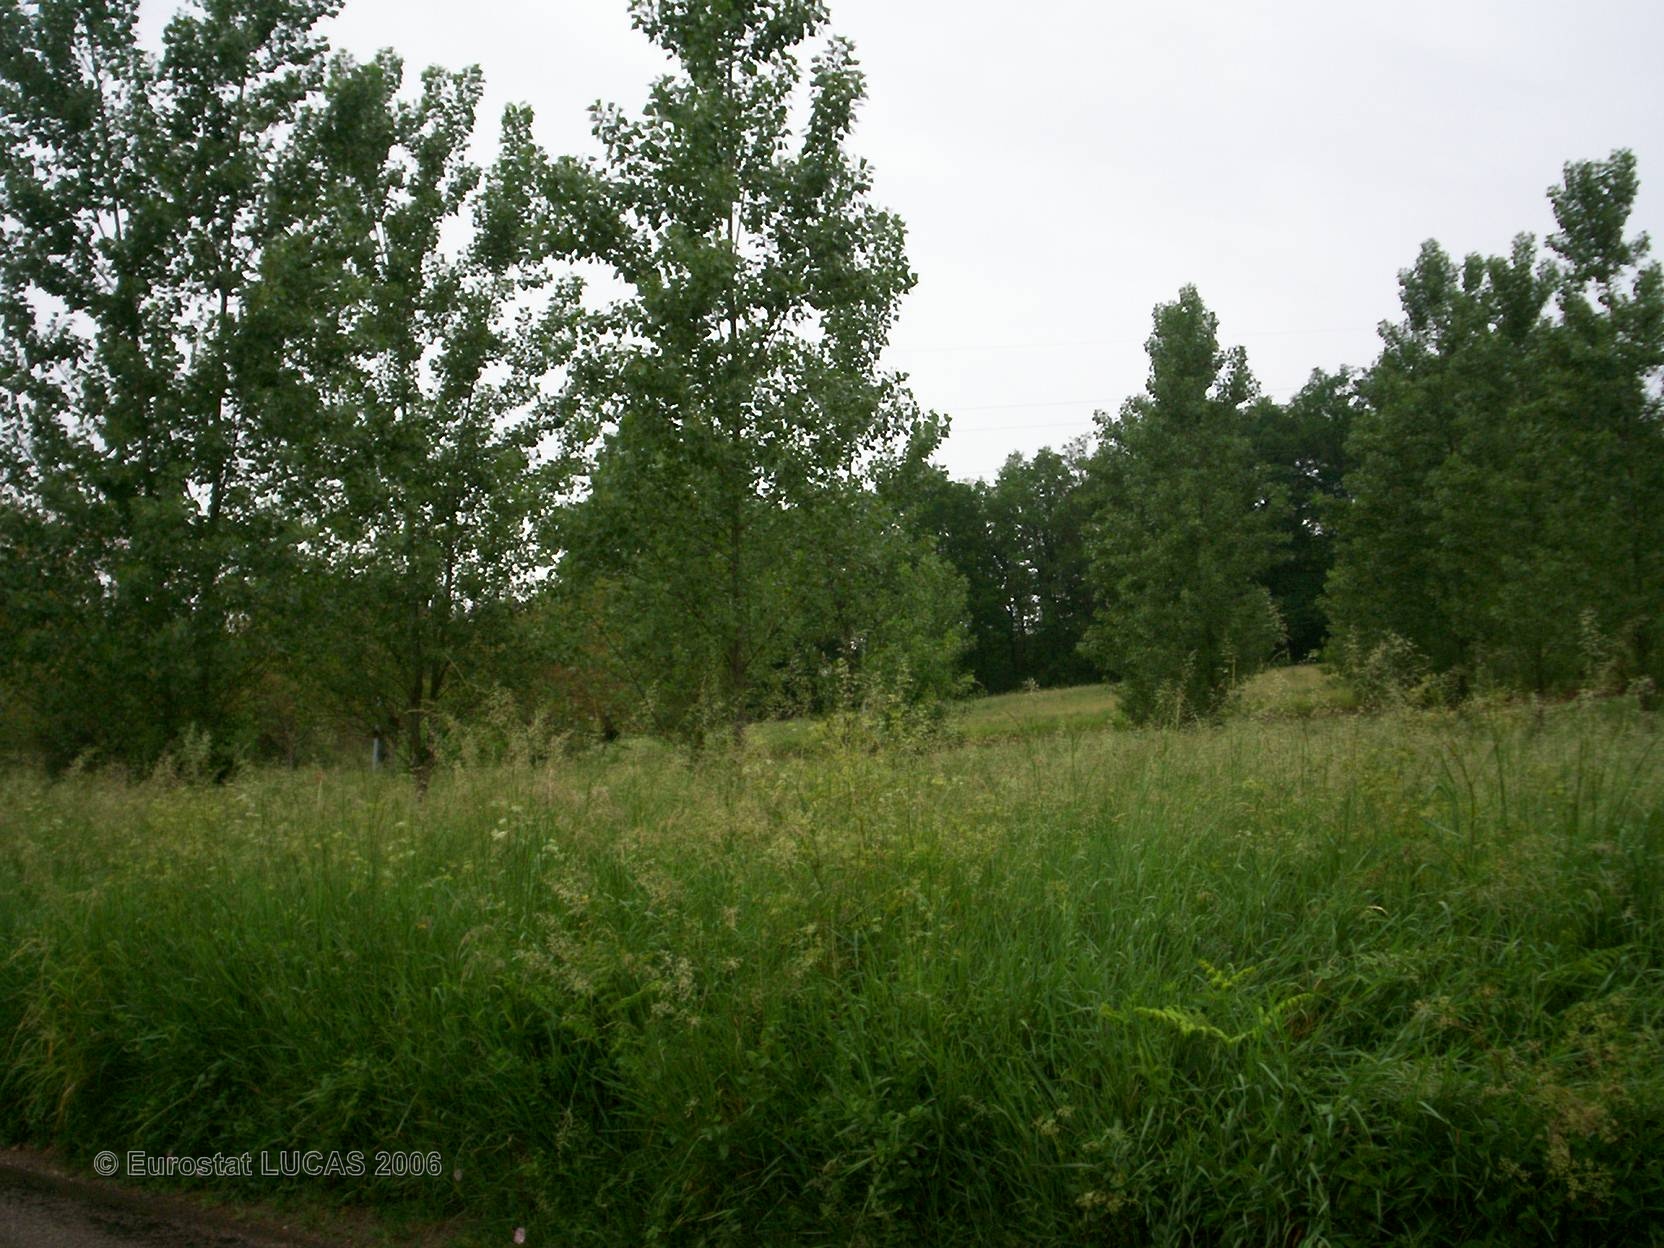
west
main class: Grassland
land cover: Grassland with sparse tree/shrub cover
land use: Agriculture (excluding fallow land and kitchen gardens)
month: May
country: FR
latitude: 44.7339
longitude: 1.3718
